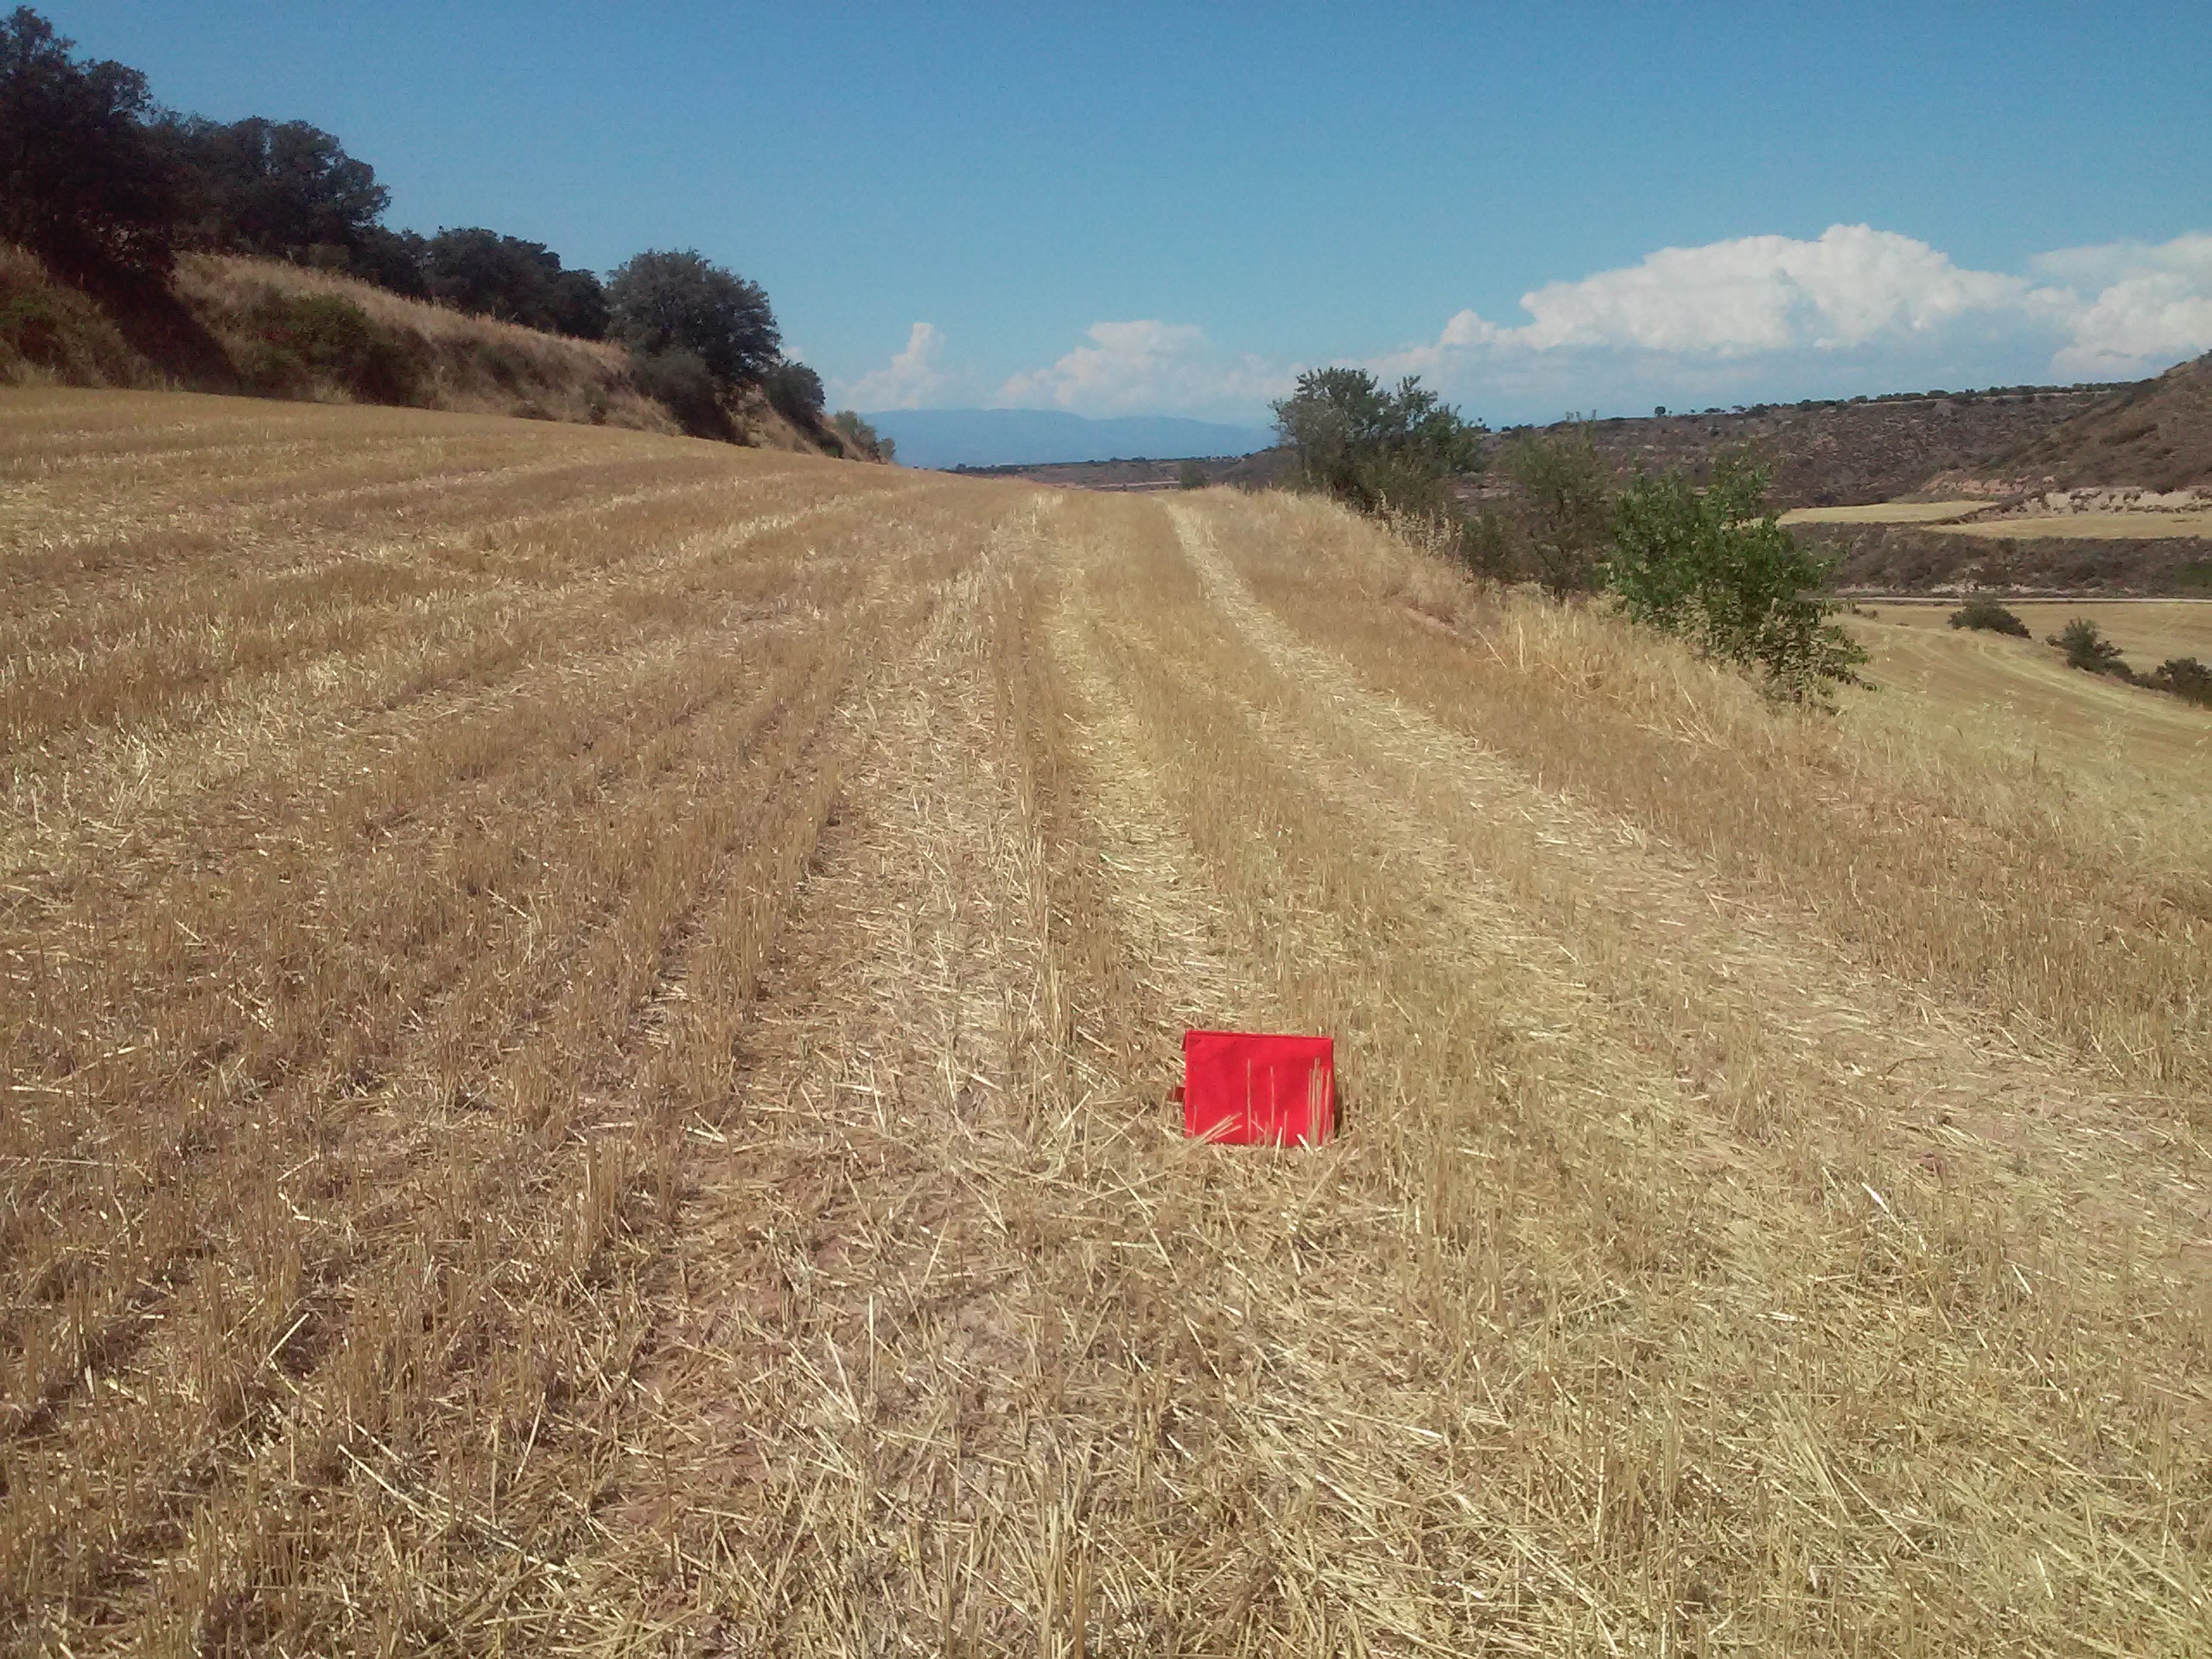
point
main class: Cropland
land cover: Barley
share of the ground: < 10 %
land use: Agriculture (excluding fallow land and kitchen gardens)
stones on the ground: 10 - 25 %
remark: Harvested field
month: July
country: ES
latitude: 41.6339
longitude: 1.1908
